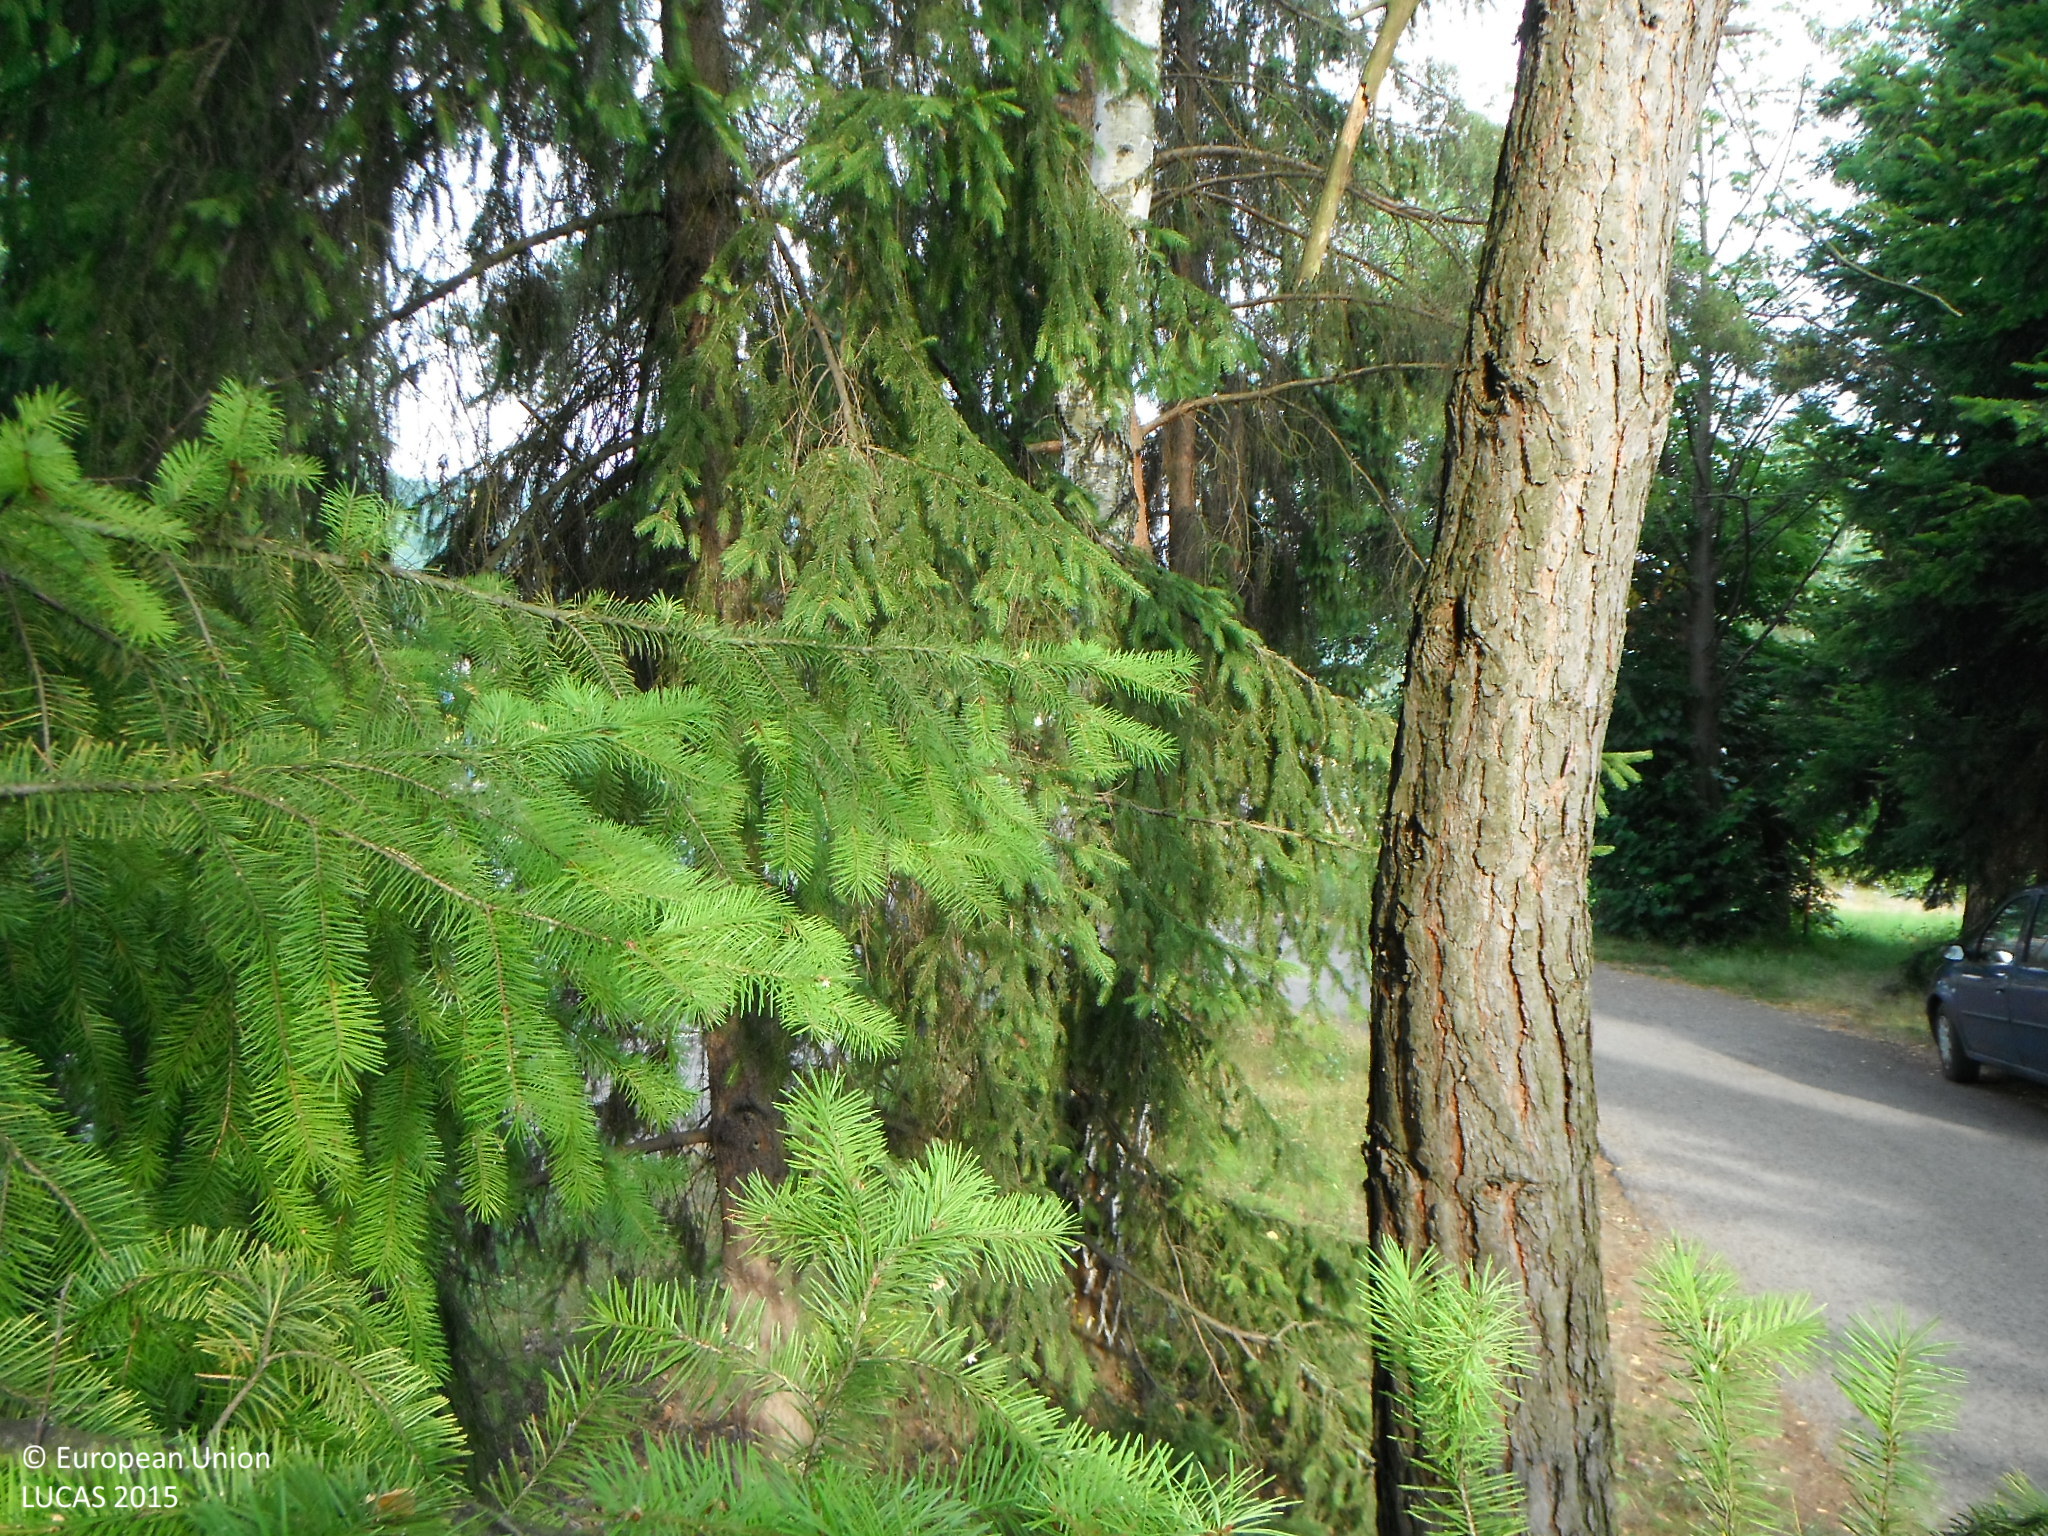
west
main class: Woodland
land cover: Other mixed woodland
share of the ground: > 75 %
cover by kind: coniferous forest trees 50 %, broadleaved forest trees 50 %
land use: Residential
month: July
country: SK
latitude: 48.5695
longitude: 19.1152
